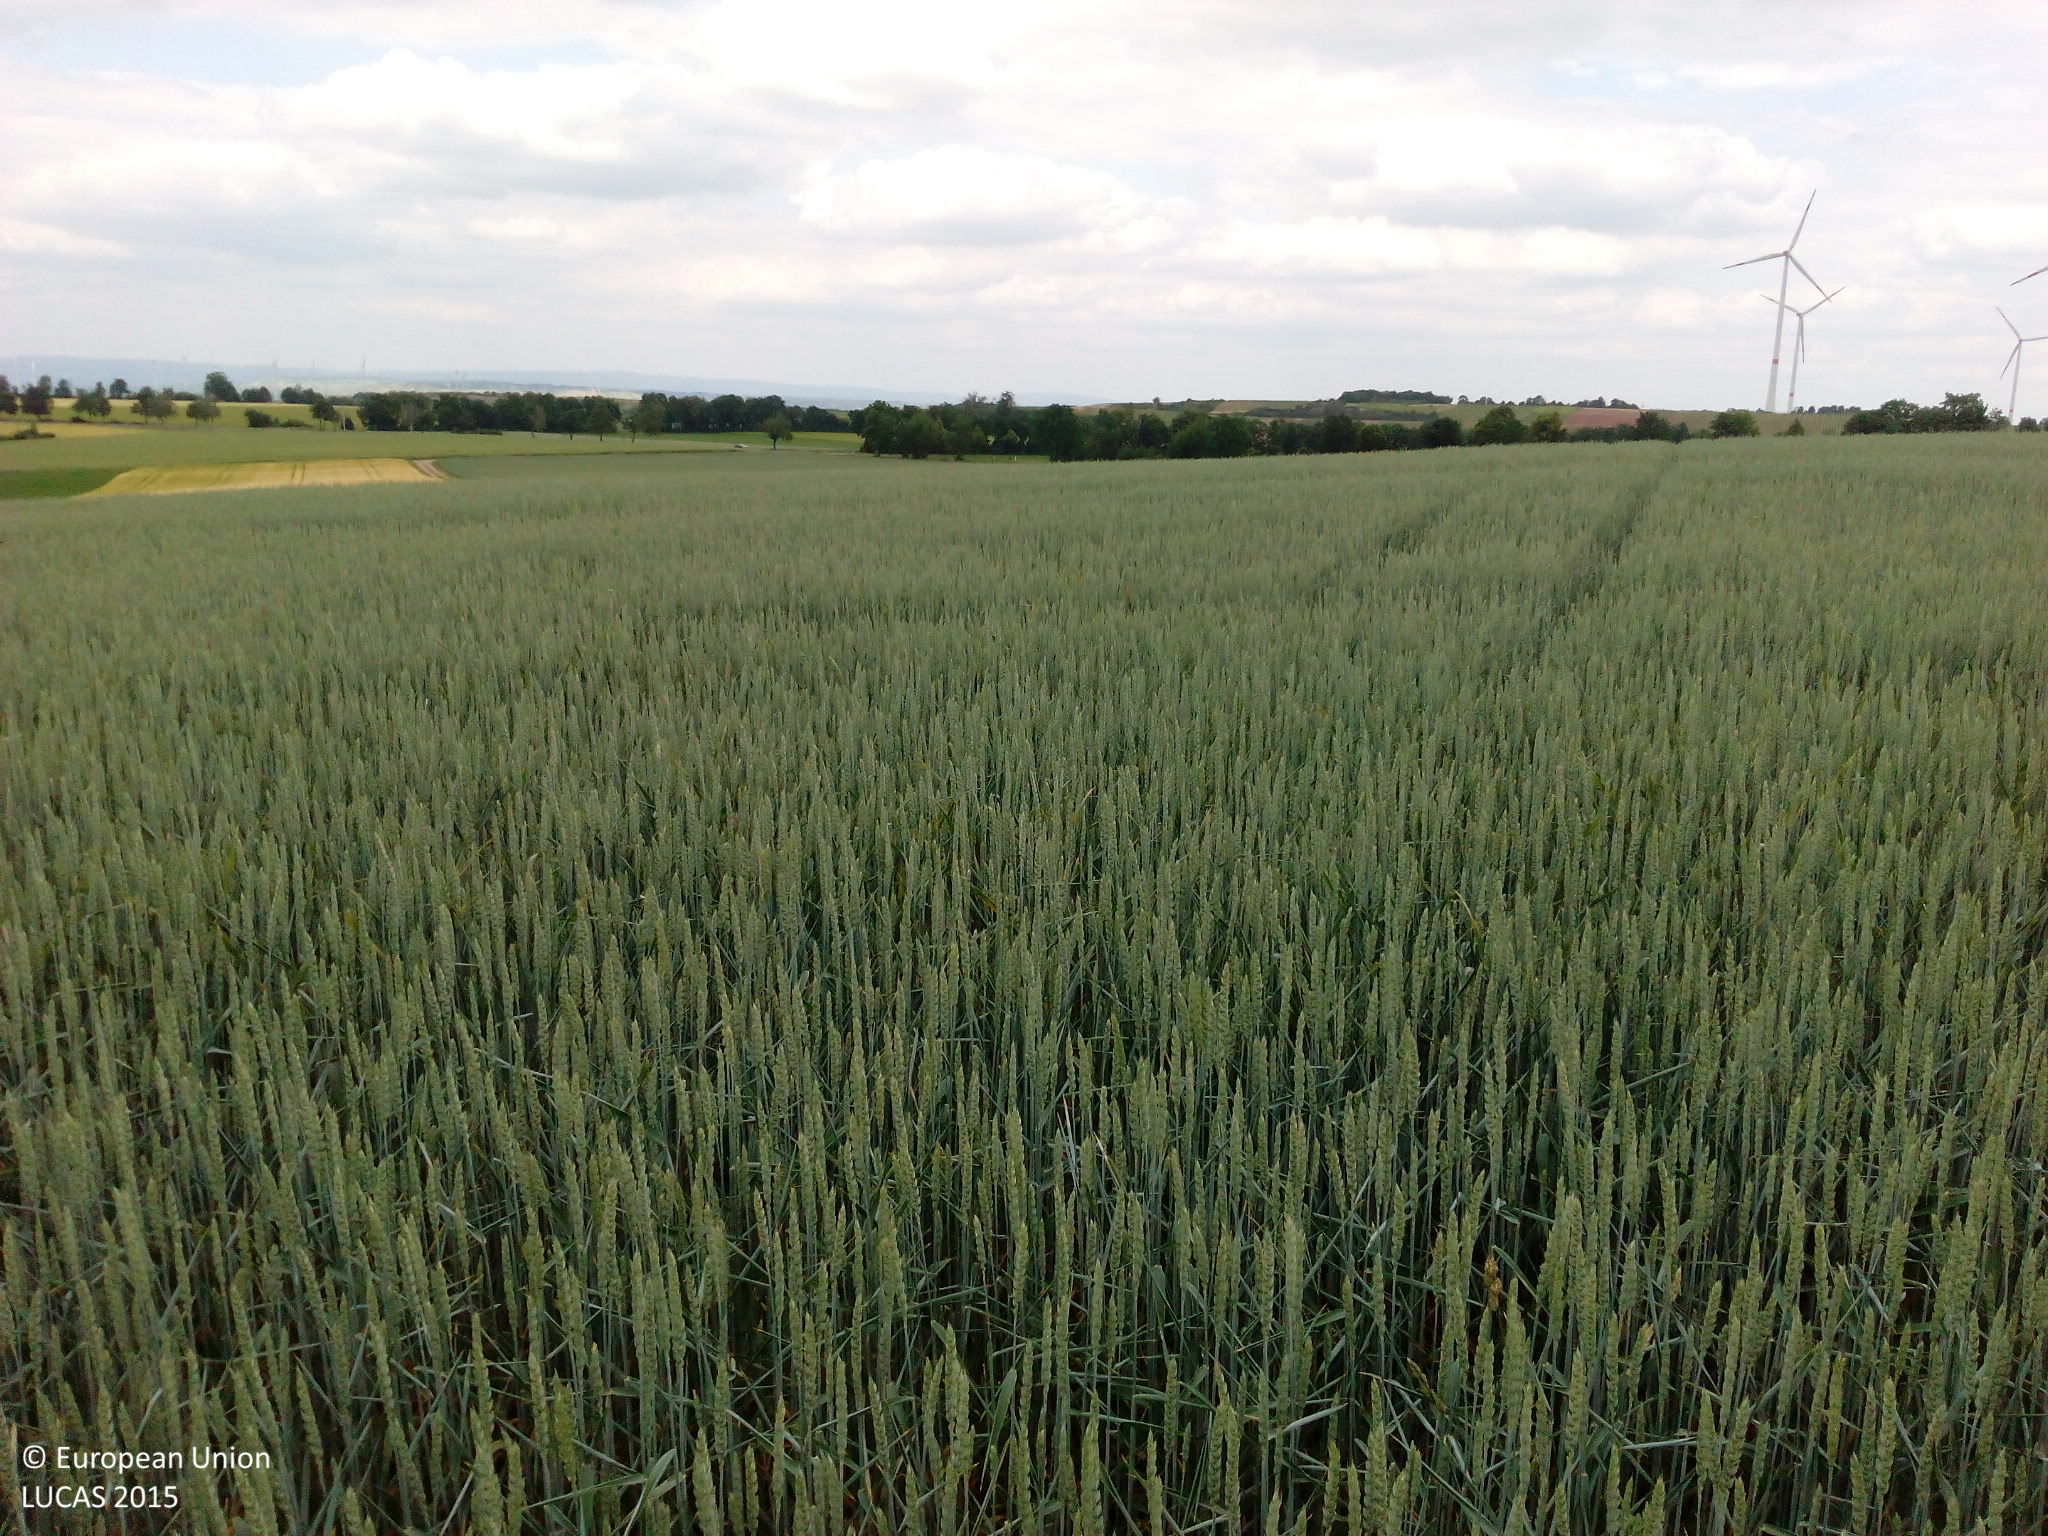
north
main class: Cropland
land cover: Common wheat
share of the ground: > 75 %
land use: Agriculture (excluding fallow land and kitchen gardens)
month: June
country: DE
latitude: 49.7537
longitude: 8.0434
